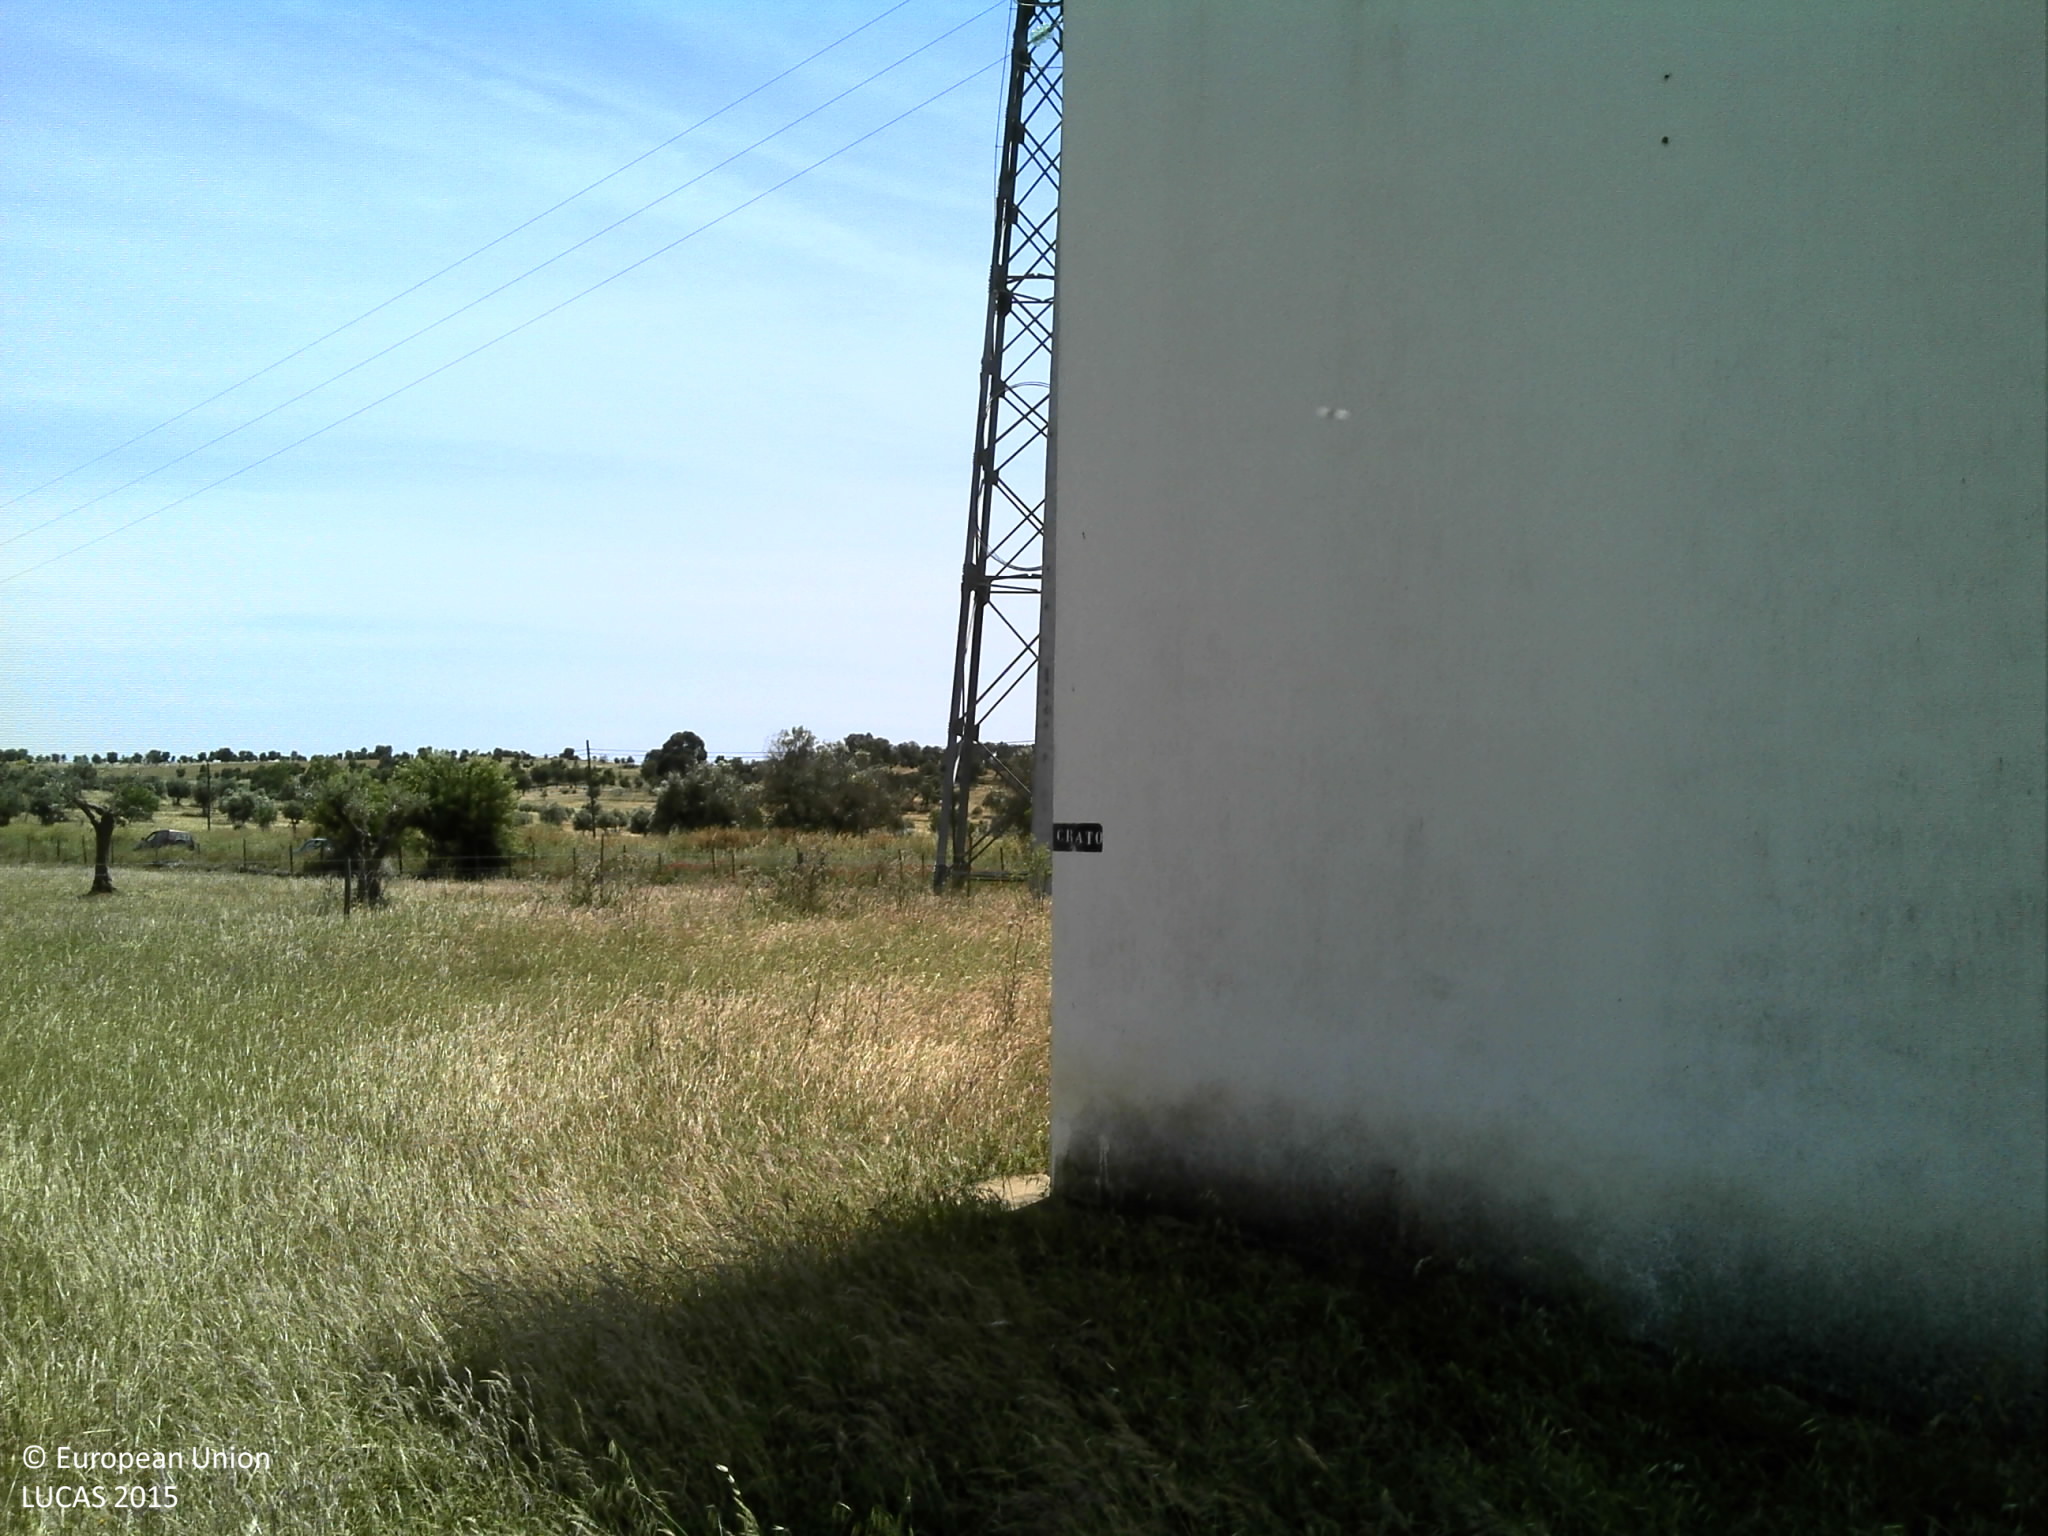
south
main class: Cropland
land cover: Olive groves
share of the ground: 10 - 25 %
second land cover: Grassland without tree/shrub cover
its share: 25 - 50 %
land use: Agriculture (excluding fallow land and kitchen gardens)
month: May
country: PT
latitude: 39.1877
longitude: -7.6540
